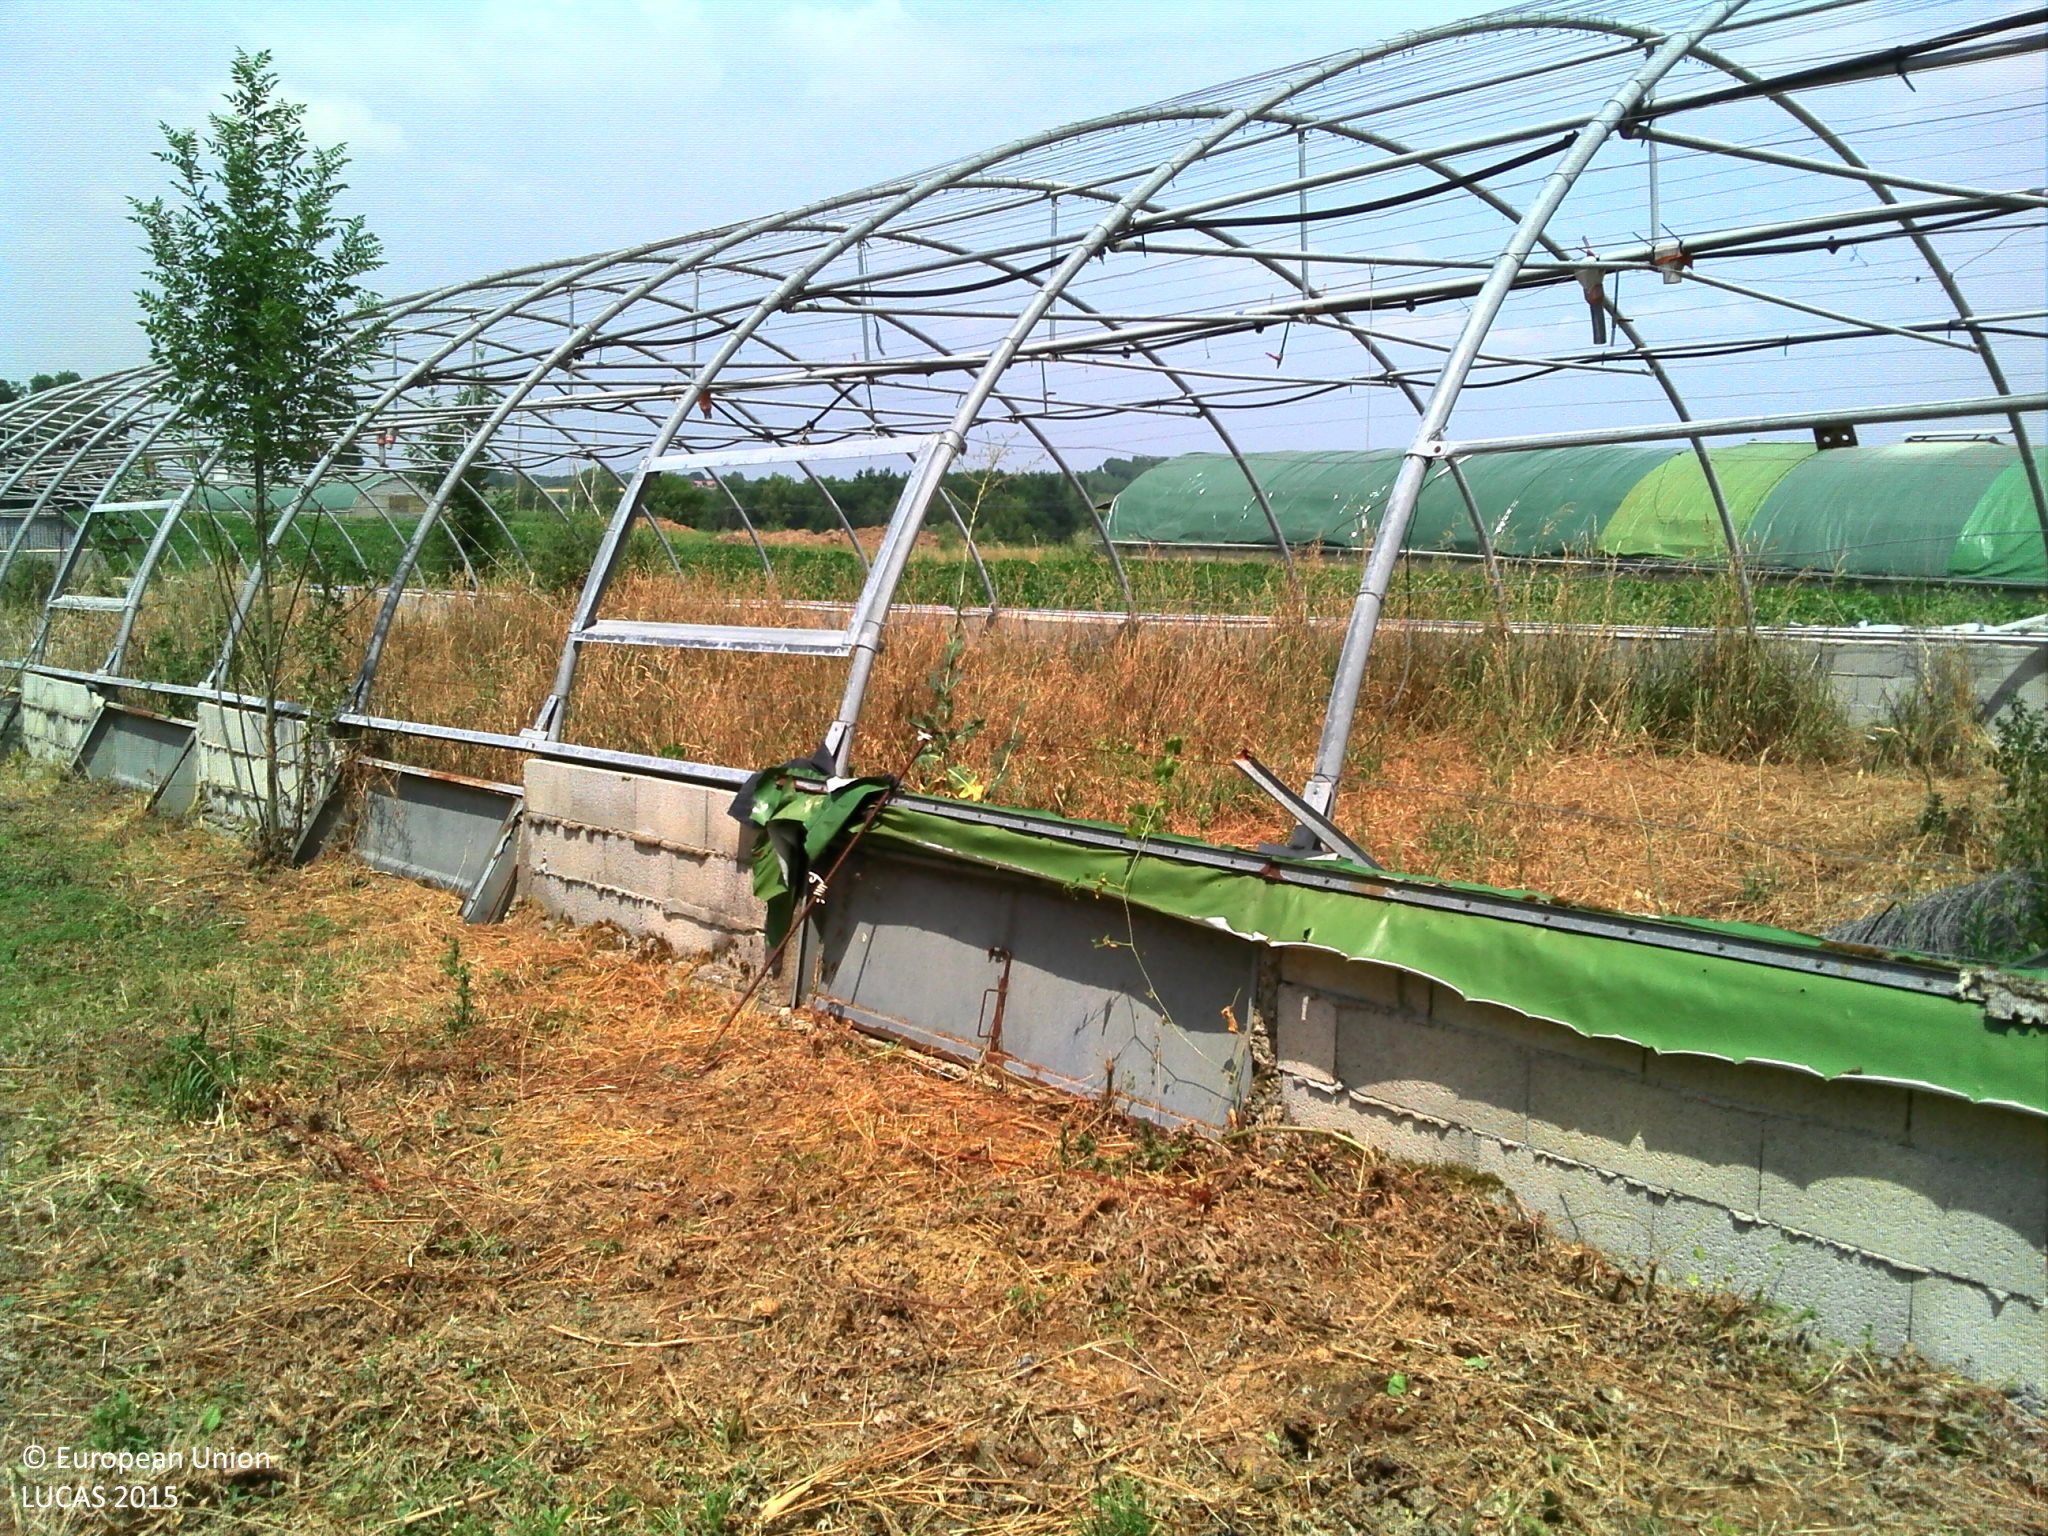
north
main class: Grassland
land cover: Grassland with sparse tree/shrub cover
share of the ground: > 75 %
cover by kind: herbaceous plants 95 %, coniferous forest trees 5 %
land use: Agriculture (excluding fallow land and kitchen gardens)
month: July
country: FR
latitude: 44.4028
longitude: 0.8921
